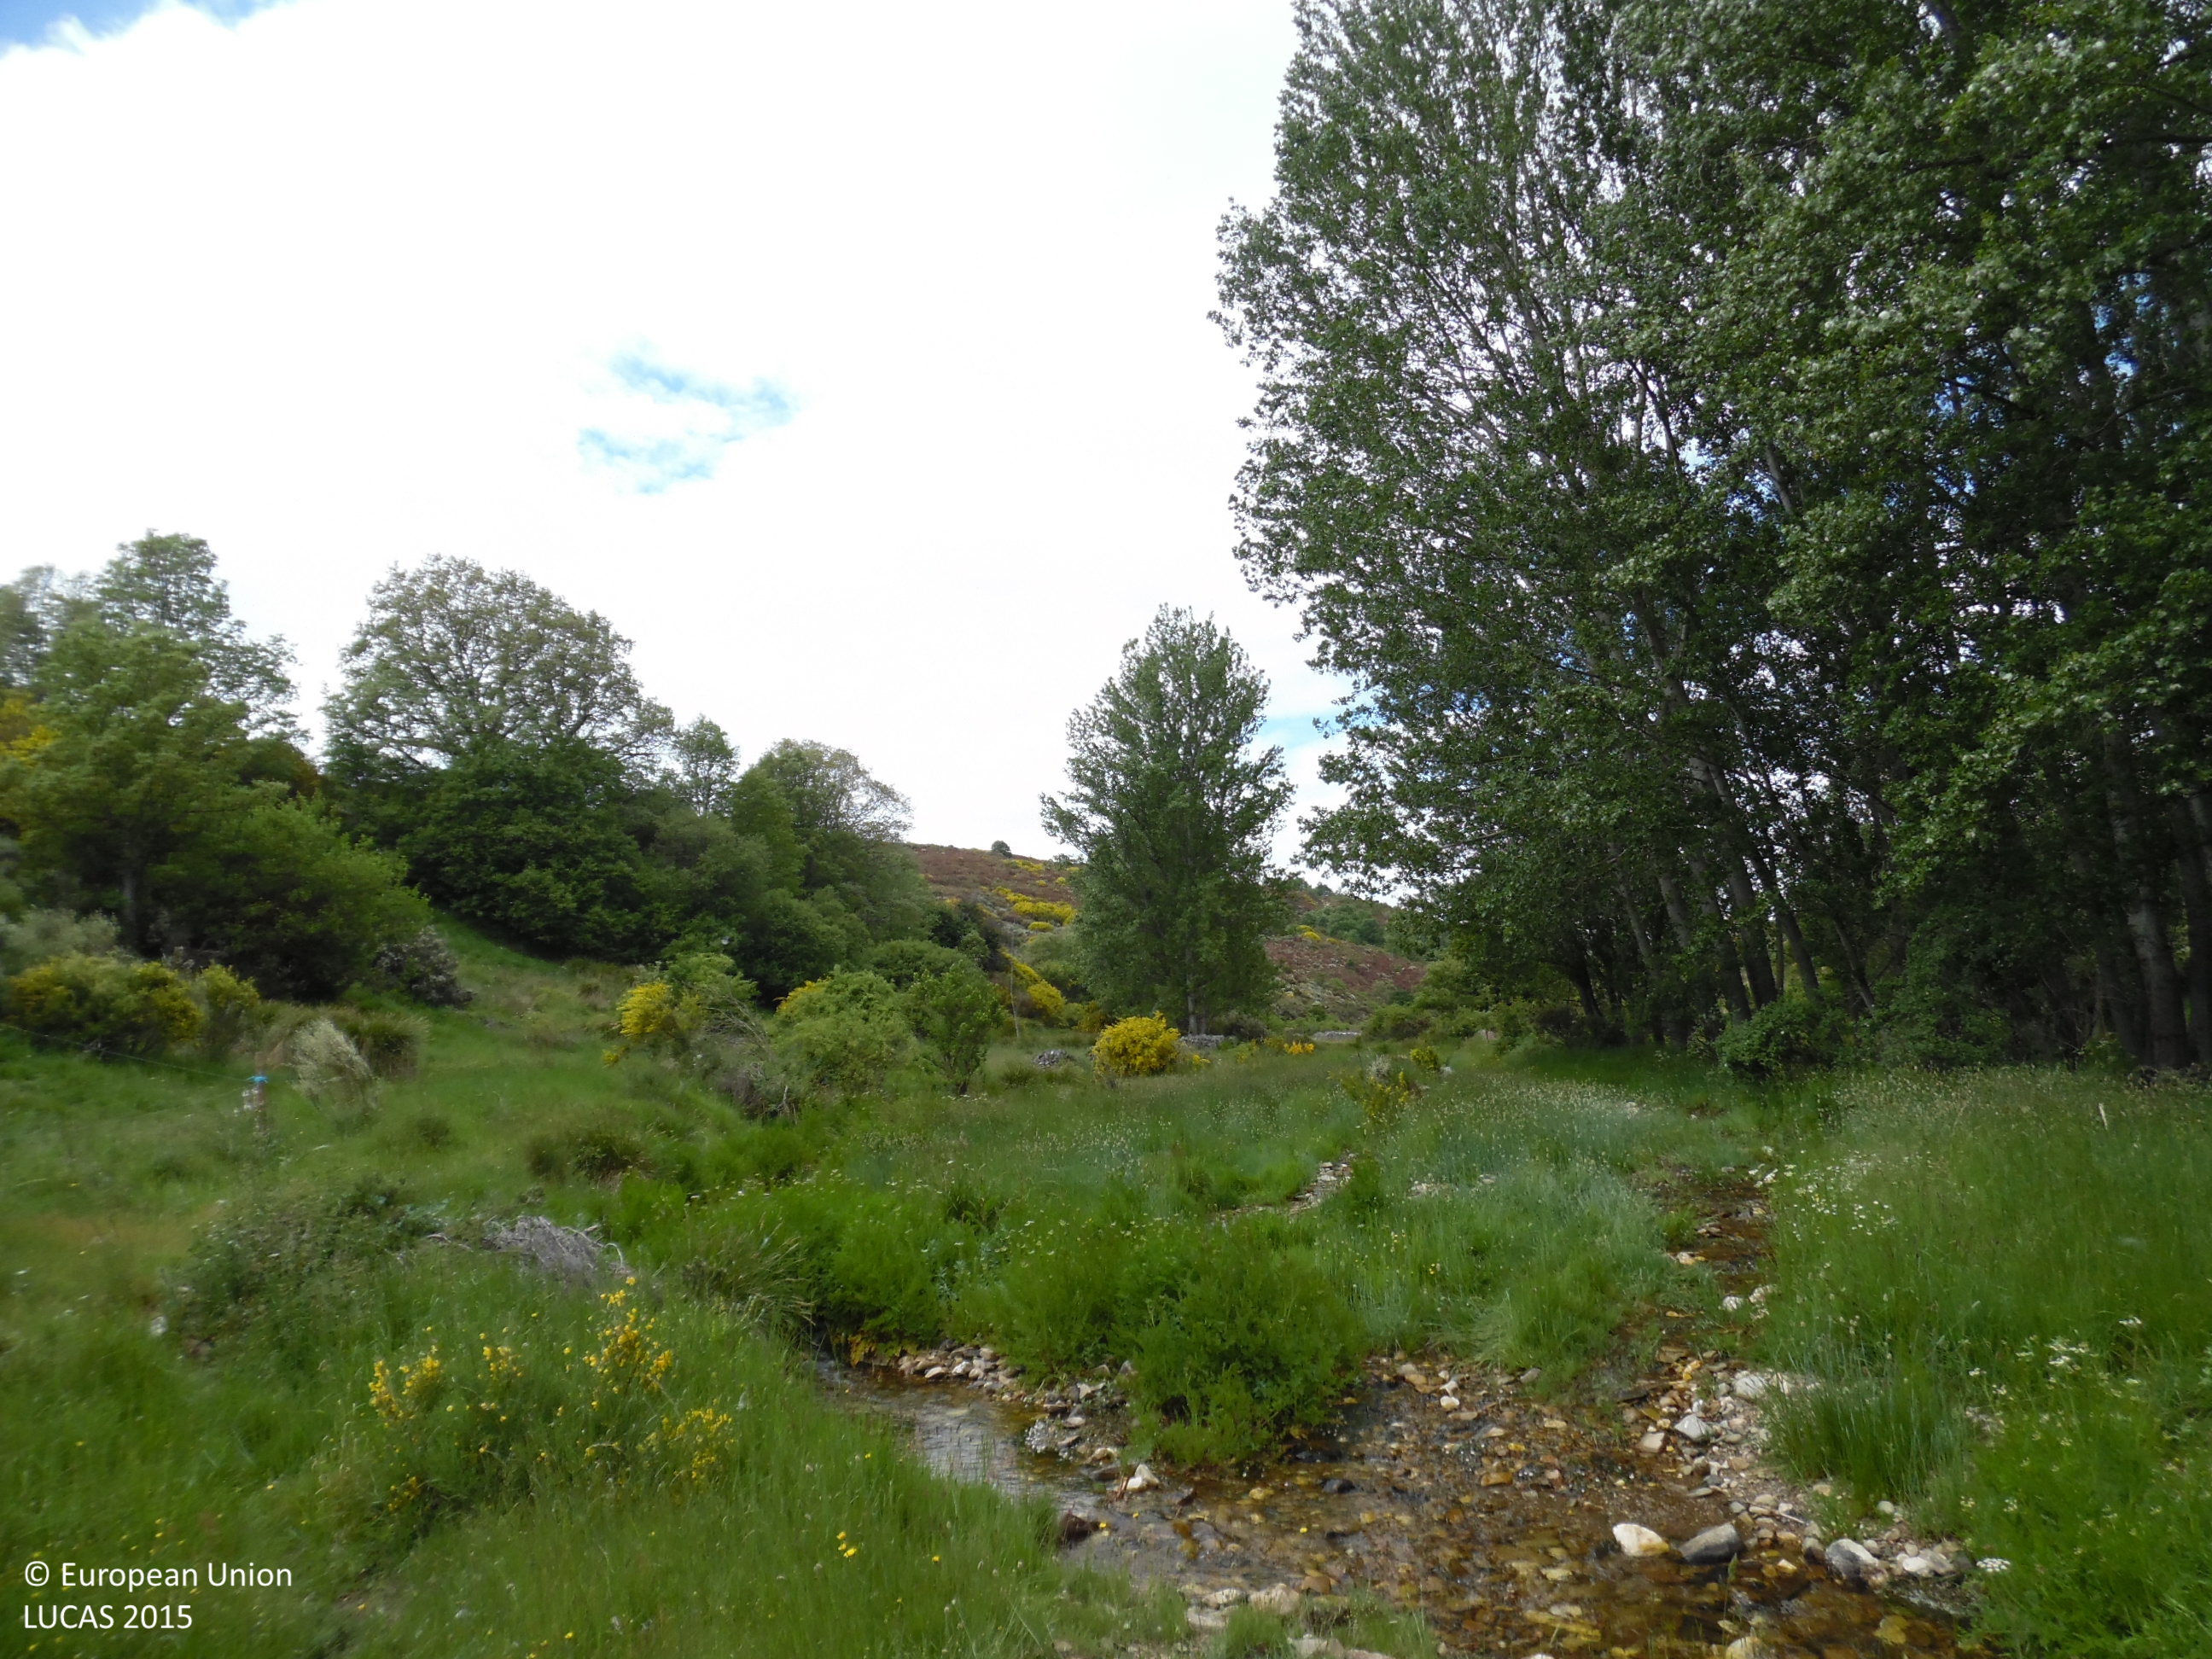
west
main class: Shrubland
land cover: Shrubland with sparse tree cover
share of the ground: > 75 %
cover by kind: shrubs 95 %, broadleaved forest trees 5 %
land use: Semi-natural and natural areas not in use
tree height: > 5 m
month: May
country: ES
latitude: 42.4556
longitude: -6.3459
